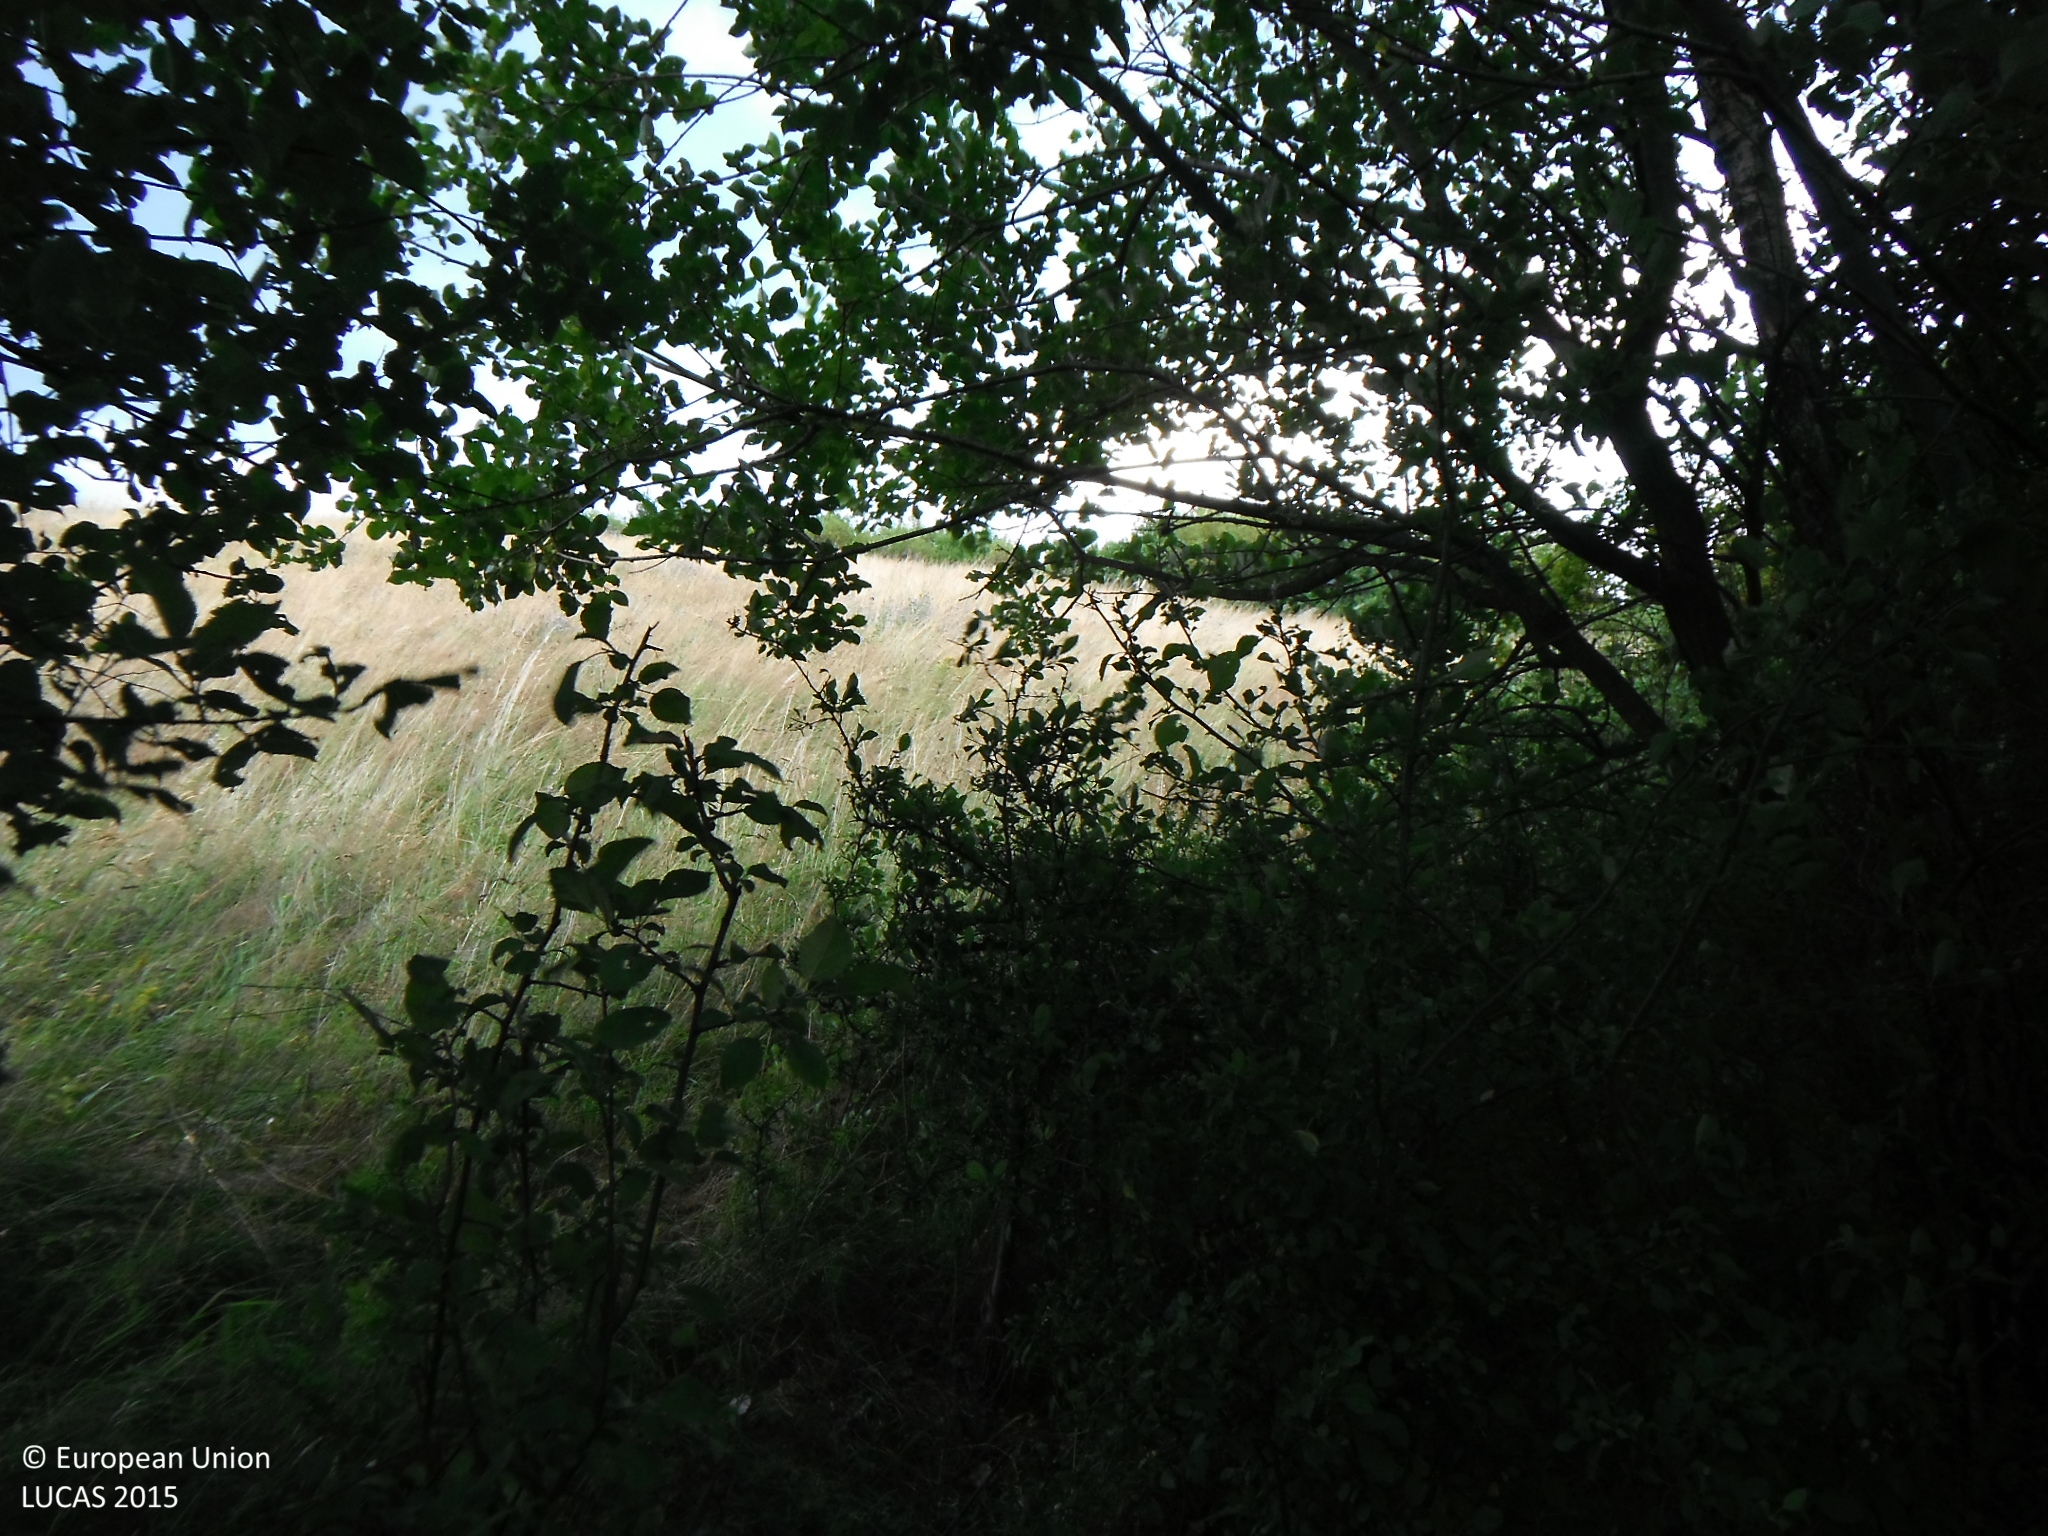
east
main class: Woodland
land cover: Broadleaved woodland
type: beech forest
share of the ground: > 75 %
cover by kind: broadleaved forest trees 100 %
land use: Forestry
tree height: > 5 m
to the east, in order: Broadleaved woodland; Rivers and streams; Broadleaved woodland; Tracks; Broadleaved woodland
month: July
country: SK
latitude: 49.3273
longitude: 21.6783
